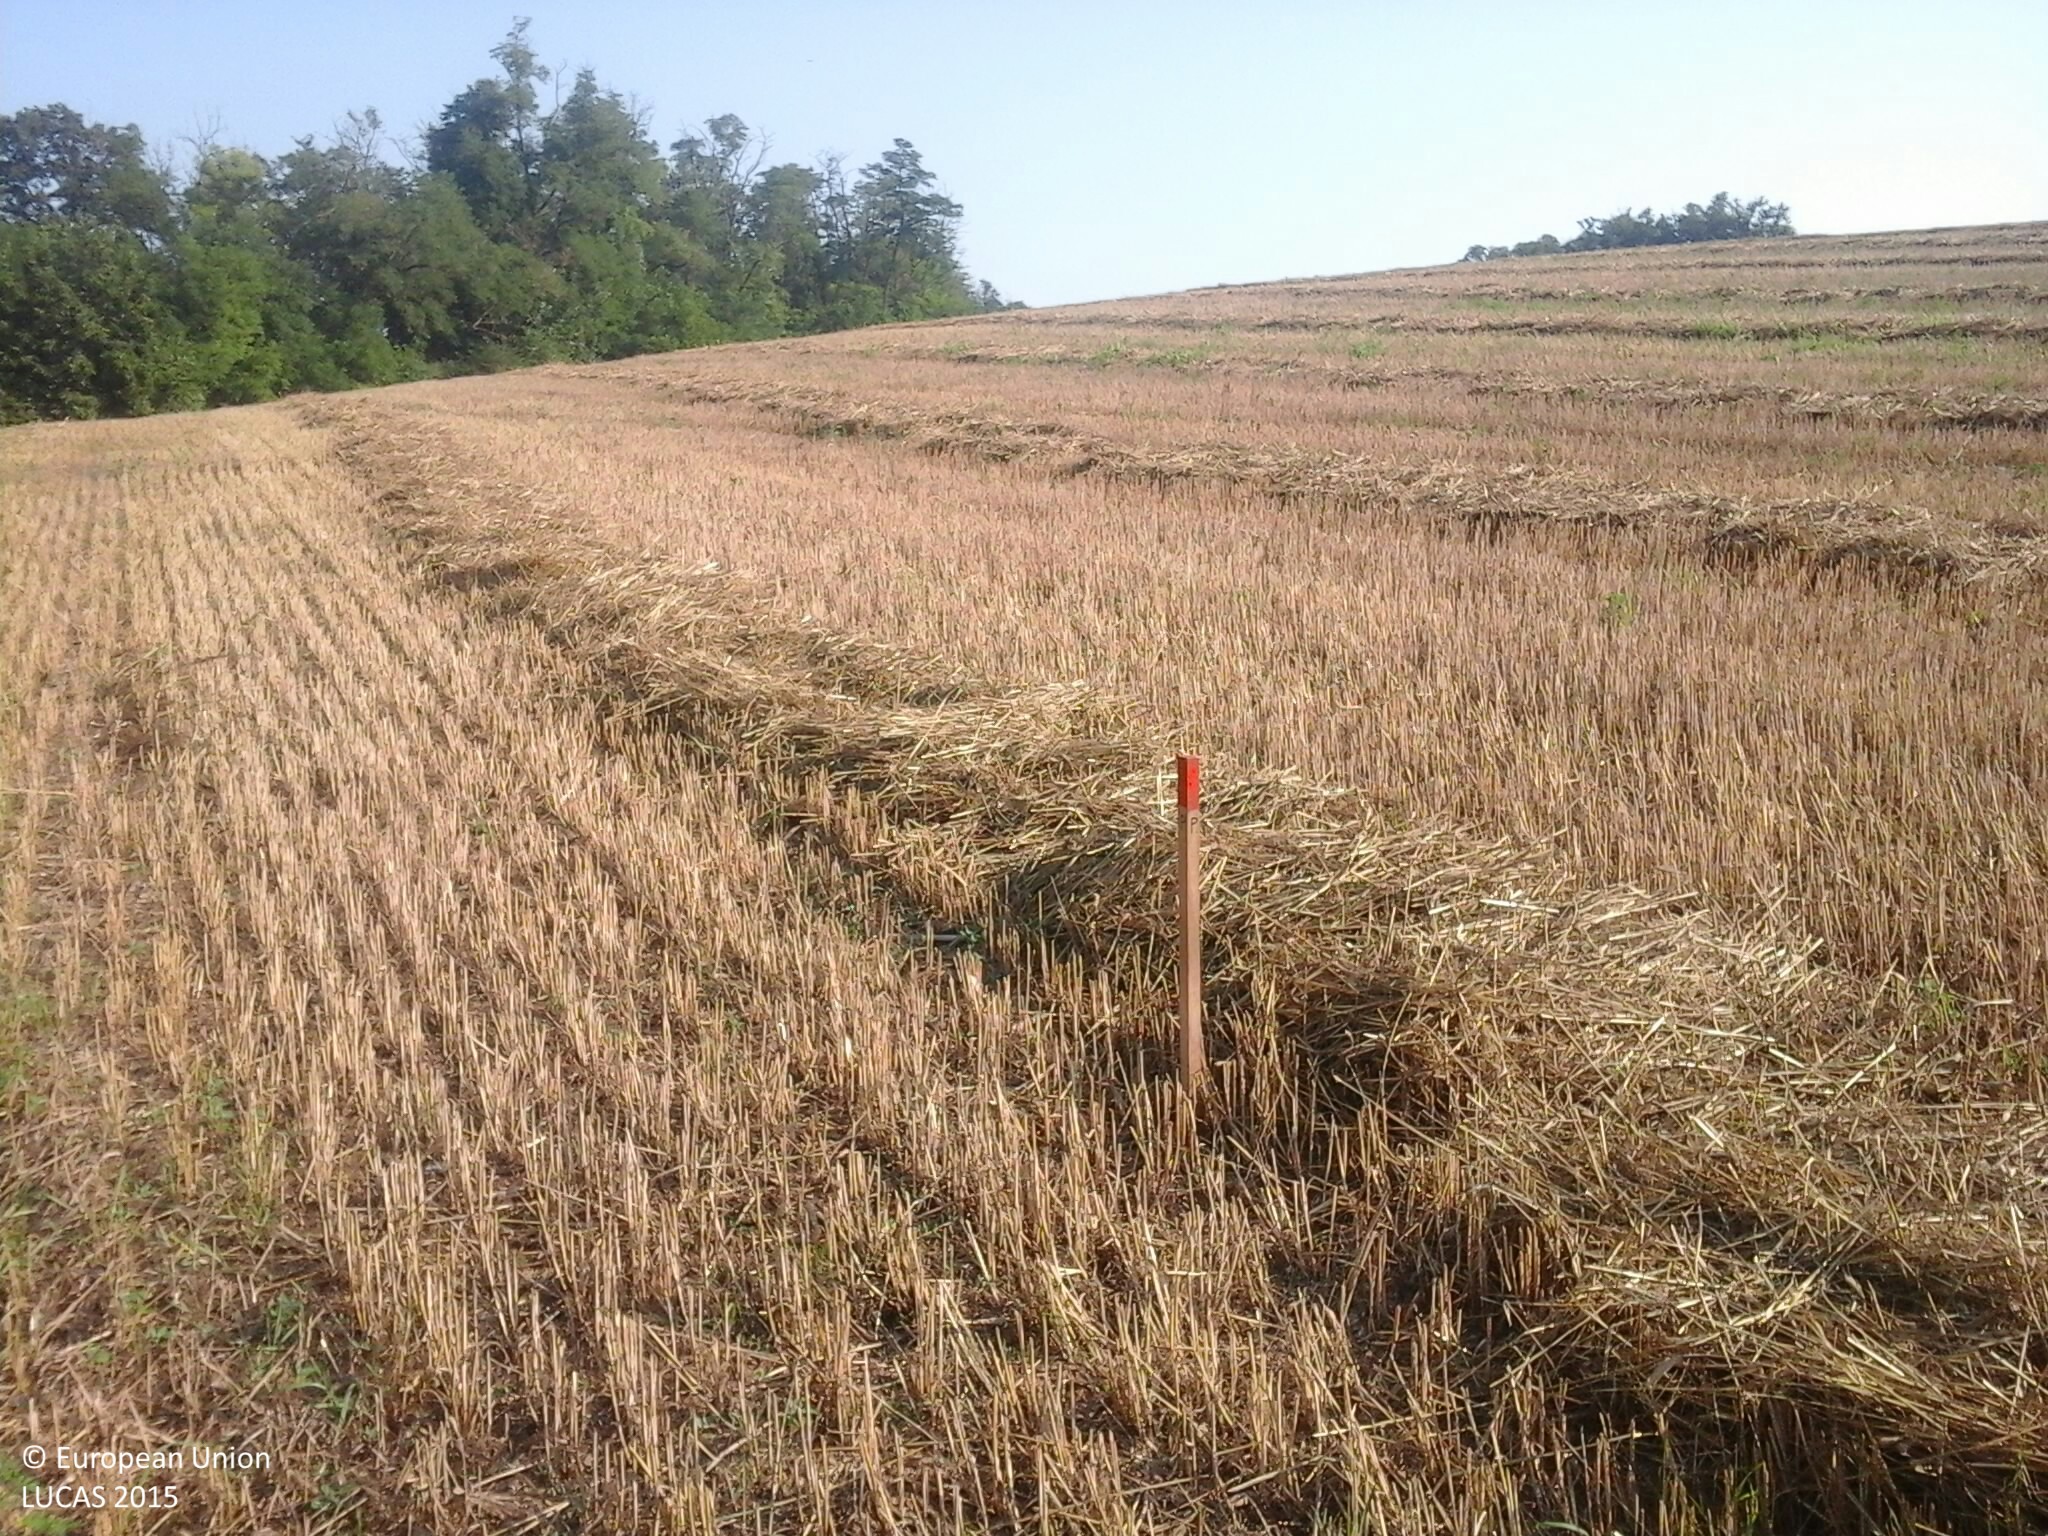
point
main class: Cropland
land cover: Durum wheat
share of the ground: > 75 %
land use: Agriculture (excluding fallow land and kitchen gardens)
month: August
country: HU
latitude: 46.7684
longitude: 18.0883
